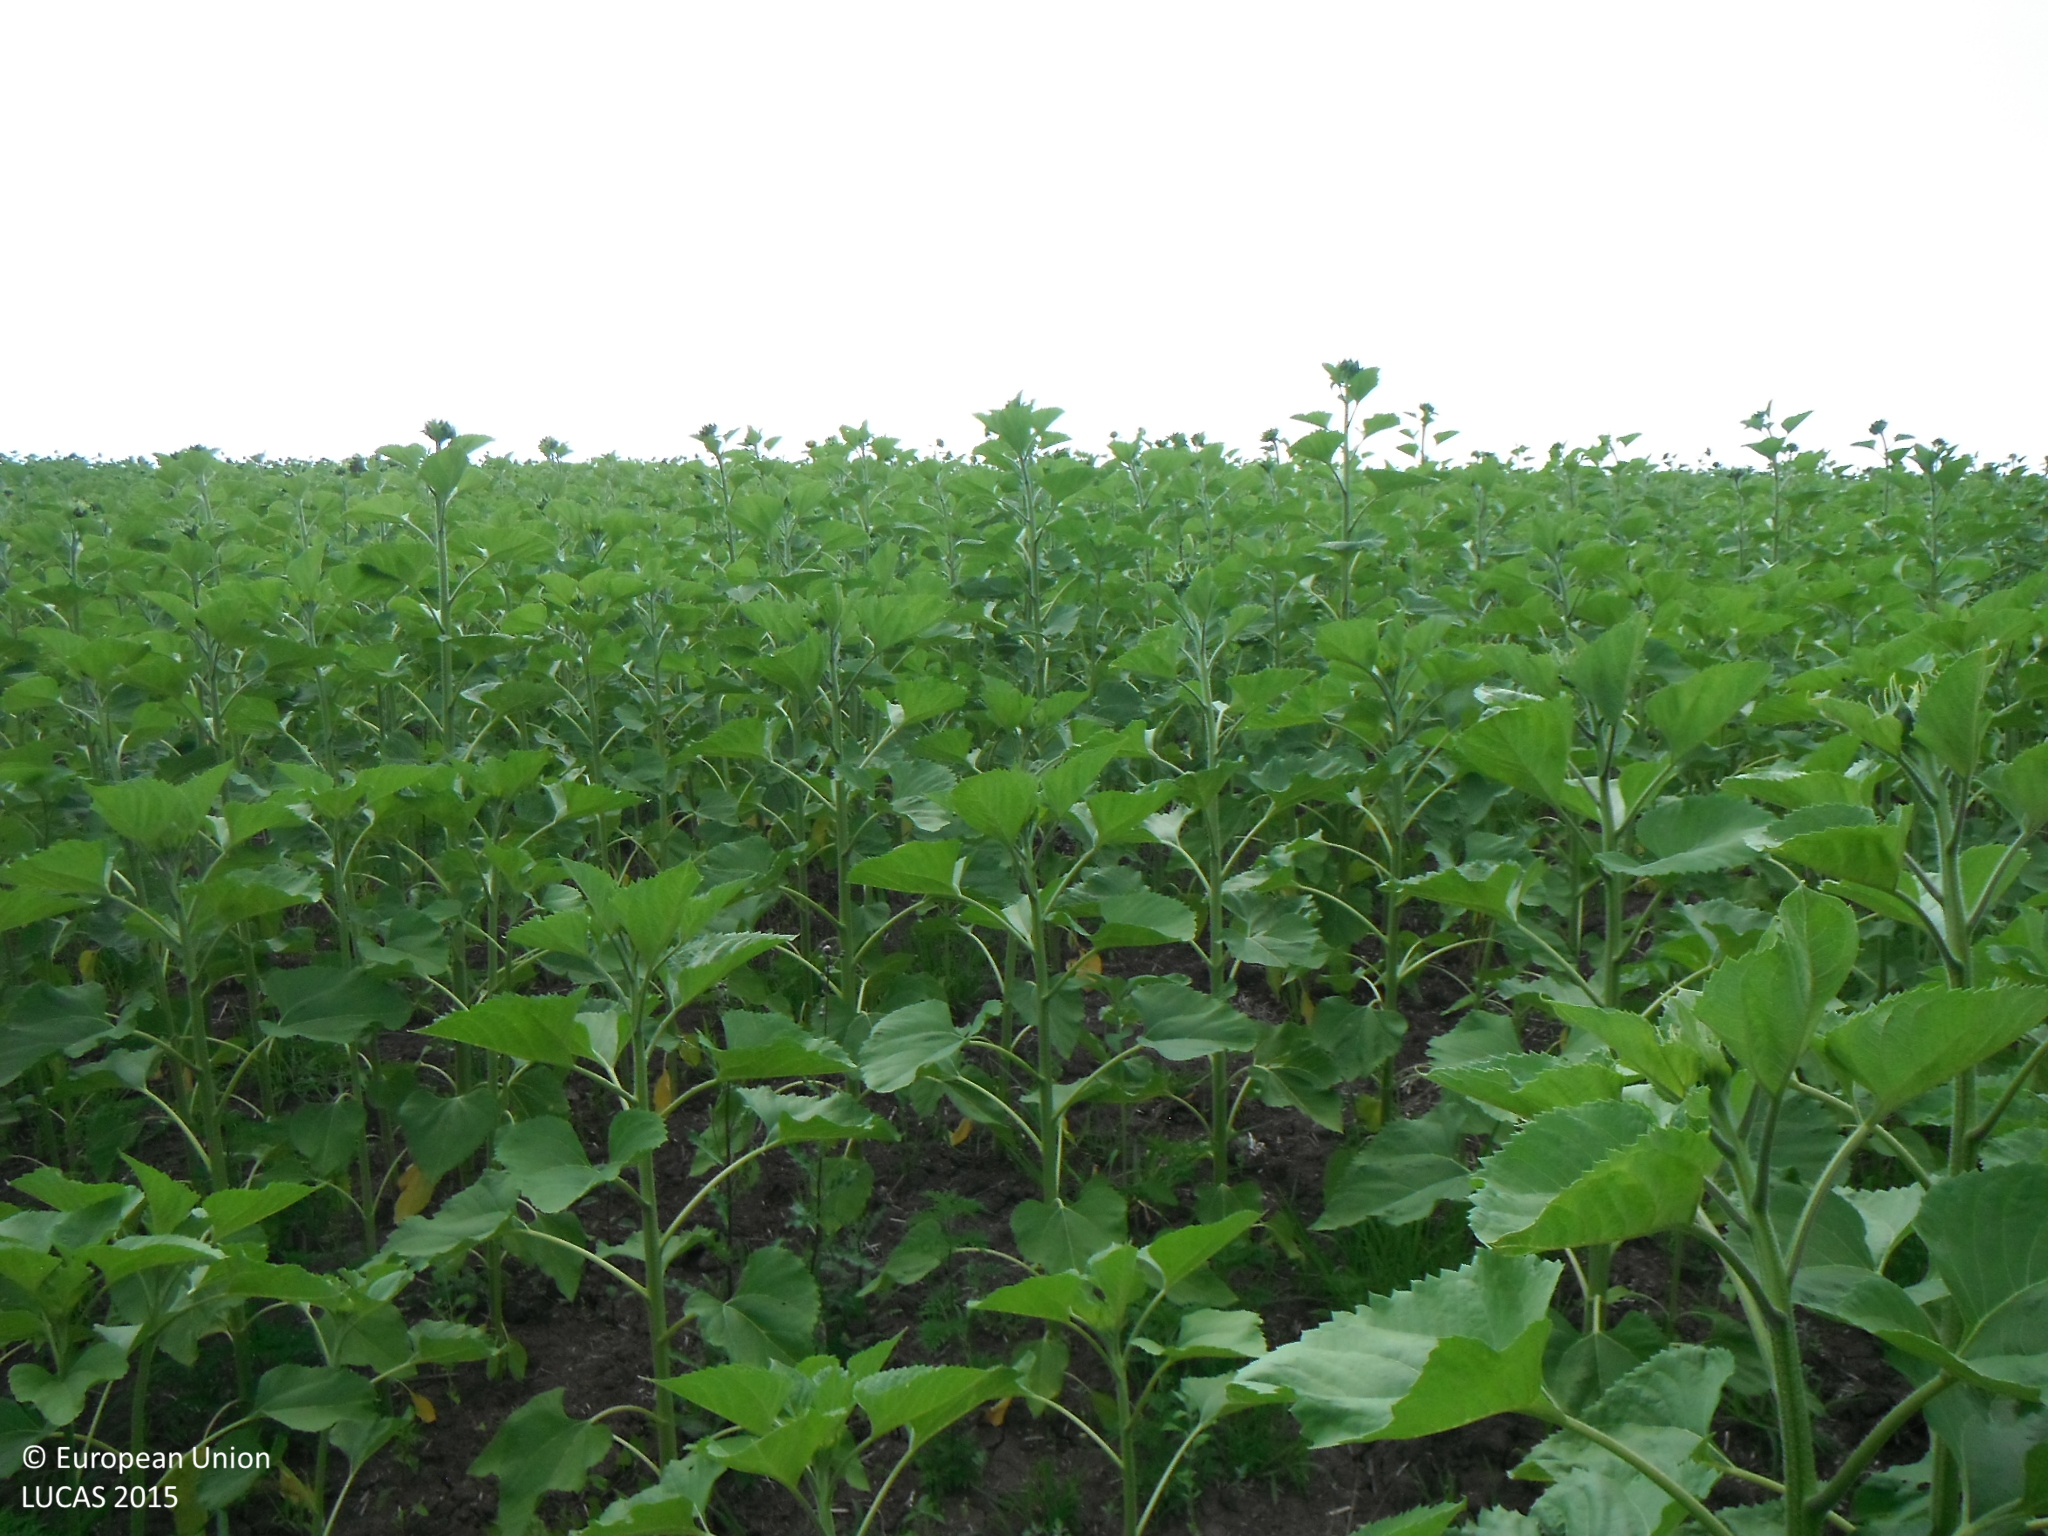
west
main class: Cropland
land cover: Sunflower
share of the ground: > 75 %
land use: Agriculture (excluding fallow land and kitchen gardens)
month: July
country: SK
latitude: 48.1035
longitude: 19.2746
